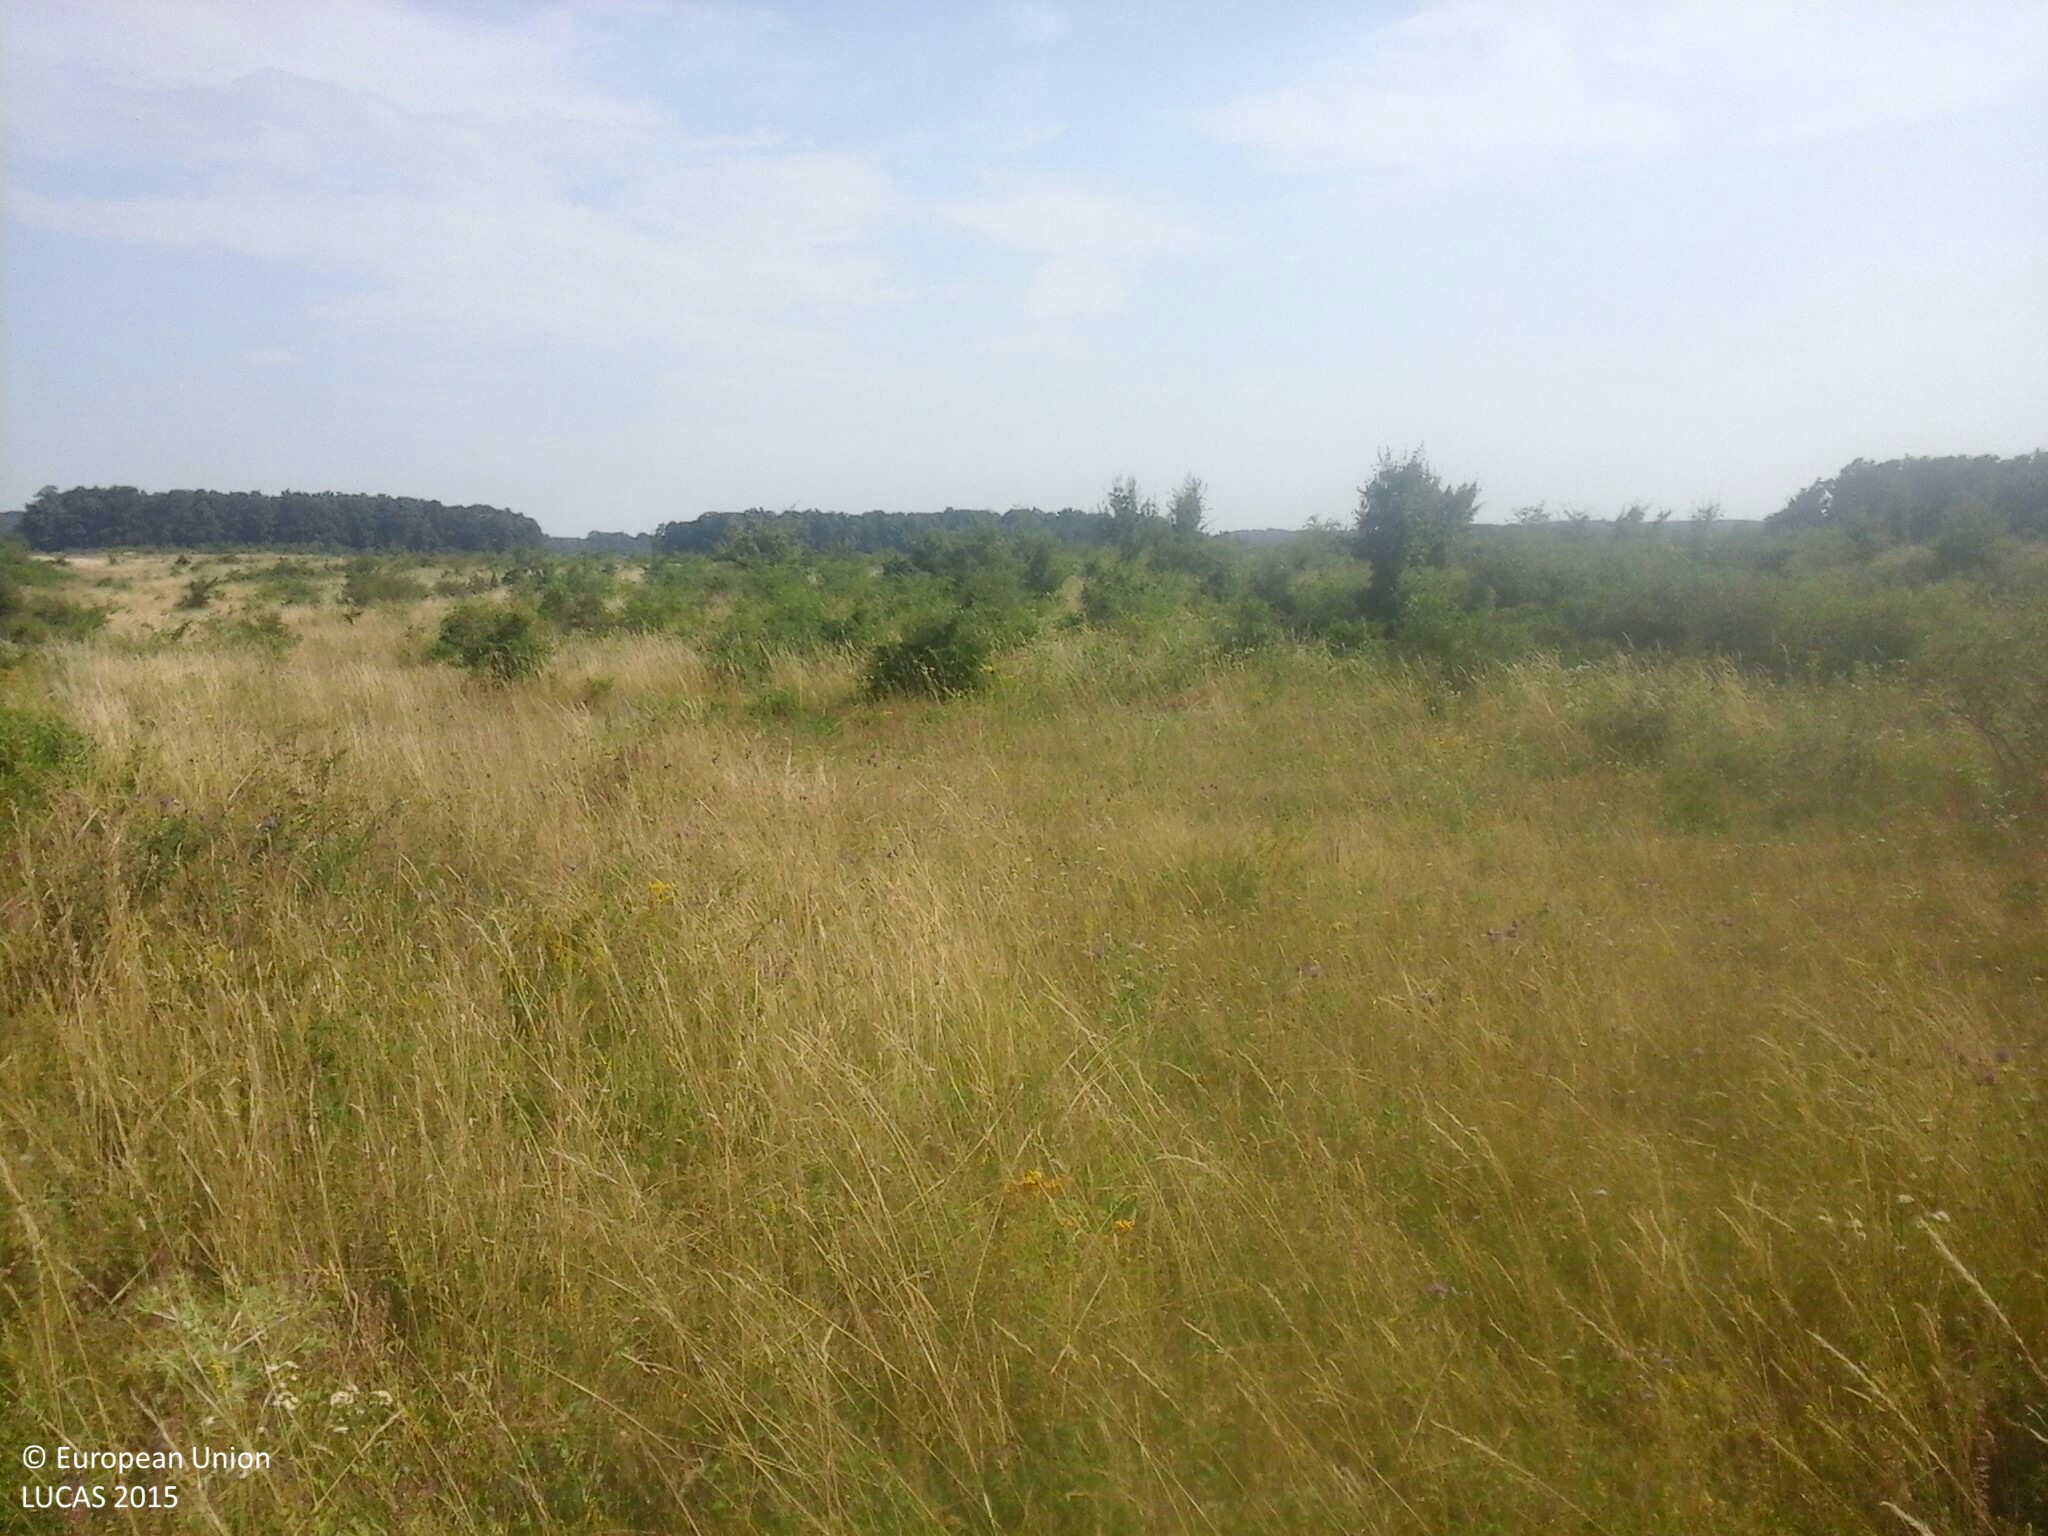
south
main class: Shrubland
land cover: Shrubland without tree cover
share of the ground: > 75 %
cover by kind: shrubs 95 %, herbaceous plants 5 %
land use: Semi-natural and natural areas not in use
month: July
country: HU
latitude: 46.9920
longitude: 17.7526
